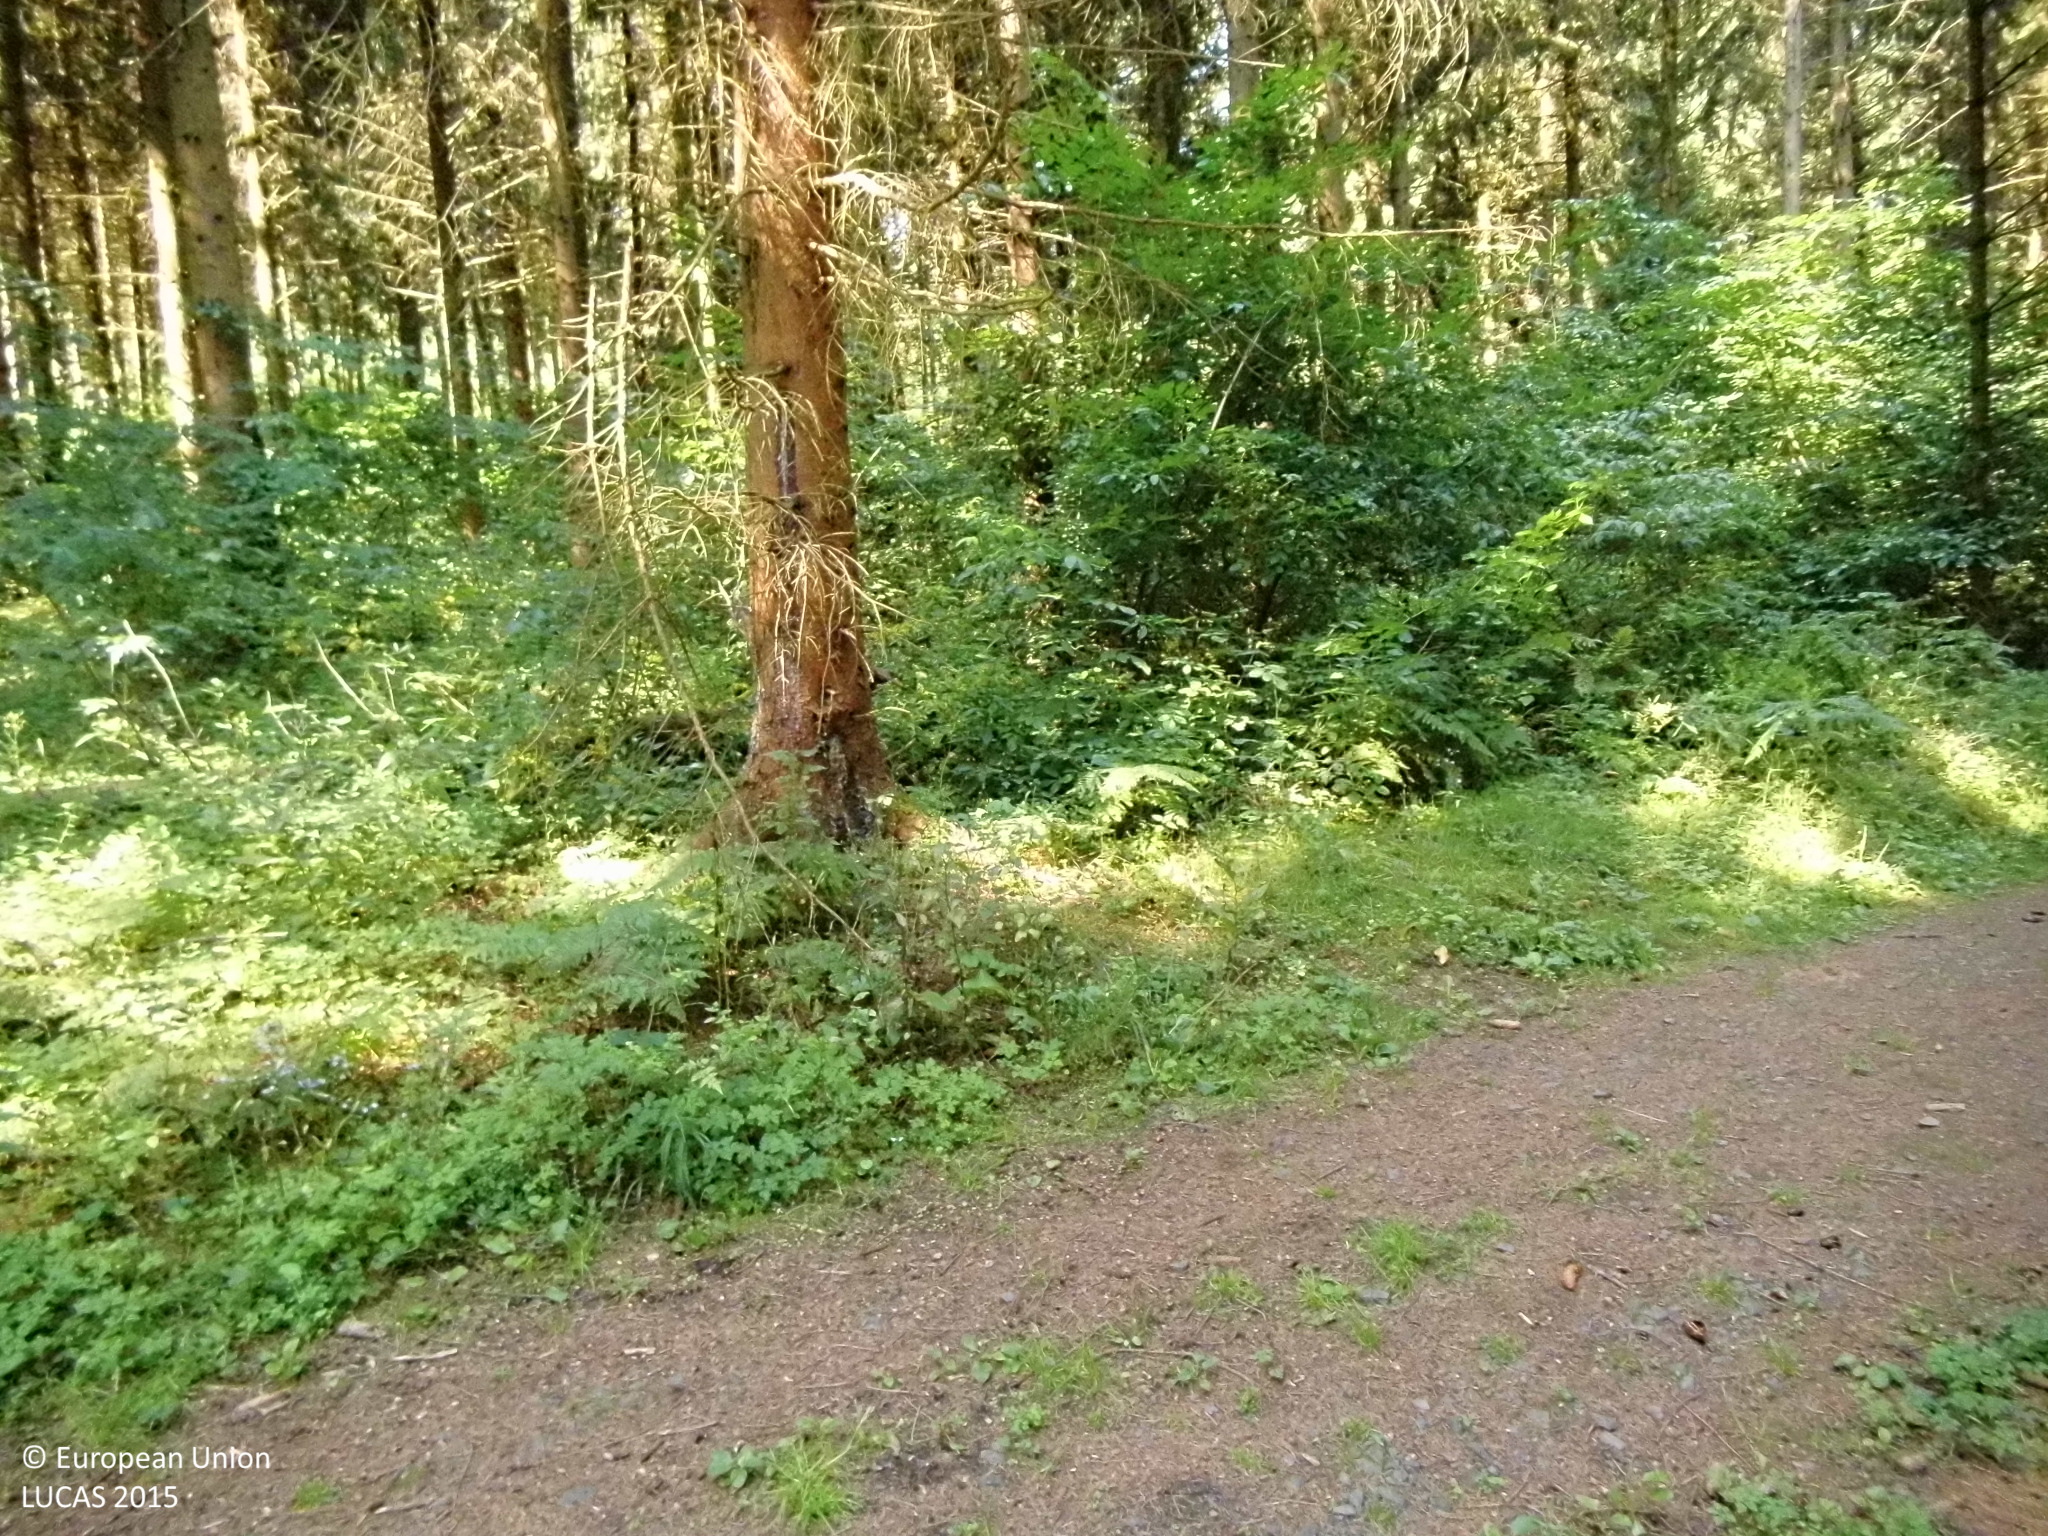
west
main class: Woodland
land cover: Spruce dominated coniferous woodland
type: hemiboreal forest and nemoral coniferous forest and mixed broadleaved-coniferous forest
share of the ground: > 75 %
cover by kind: coniferous forest trees 75 %, herbaceous plants 10 %, broadleaved forest trees 5 %, shrubs 5 %, unconsolidated bare surface 5 %
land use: Forestry
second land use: Amenities, museums, leisure
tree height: > 5 m
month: August
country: DE
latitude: 50.5626
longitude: 8.0099
